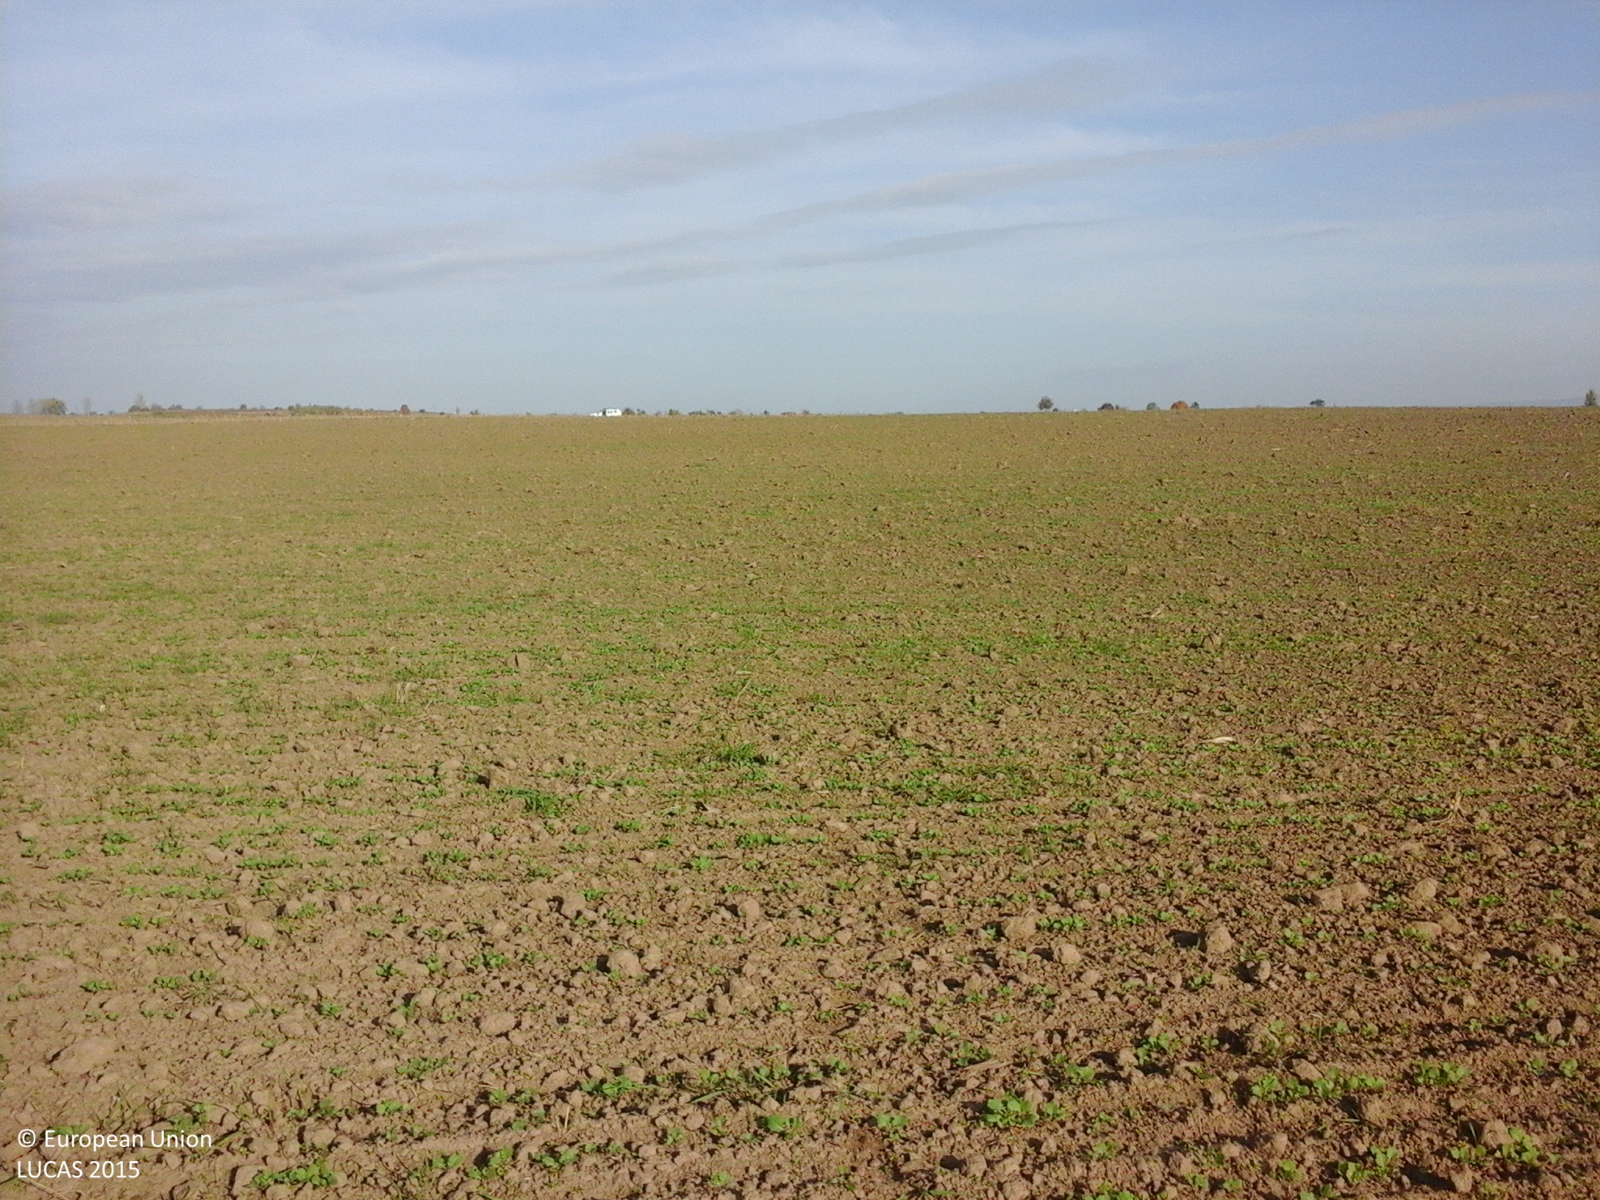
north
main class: Cropland
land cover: Rape and turnip rape
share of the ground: < 10 %
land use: Agriculture (excluding fallow land and kitchen gardens)
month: October
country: RO
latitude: 46.0141
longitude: 27.1849
